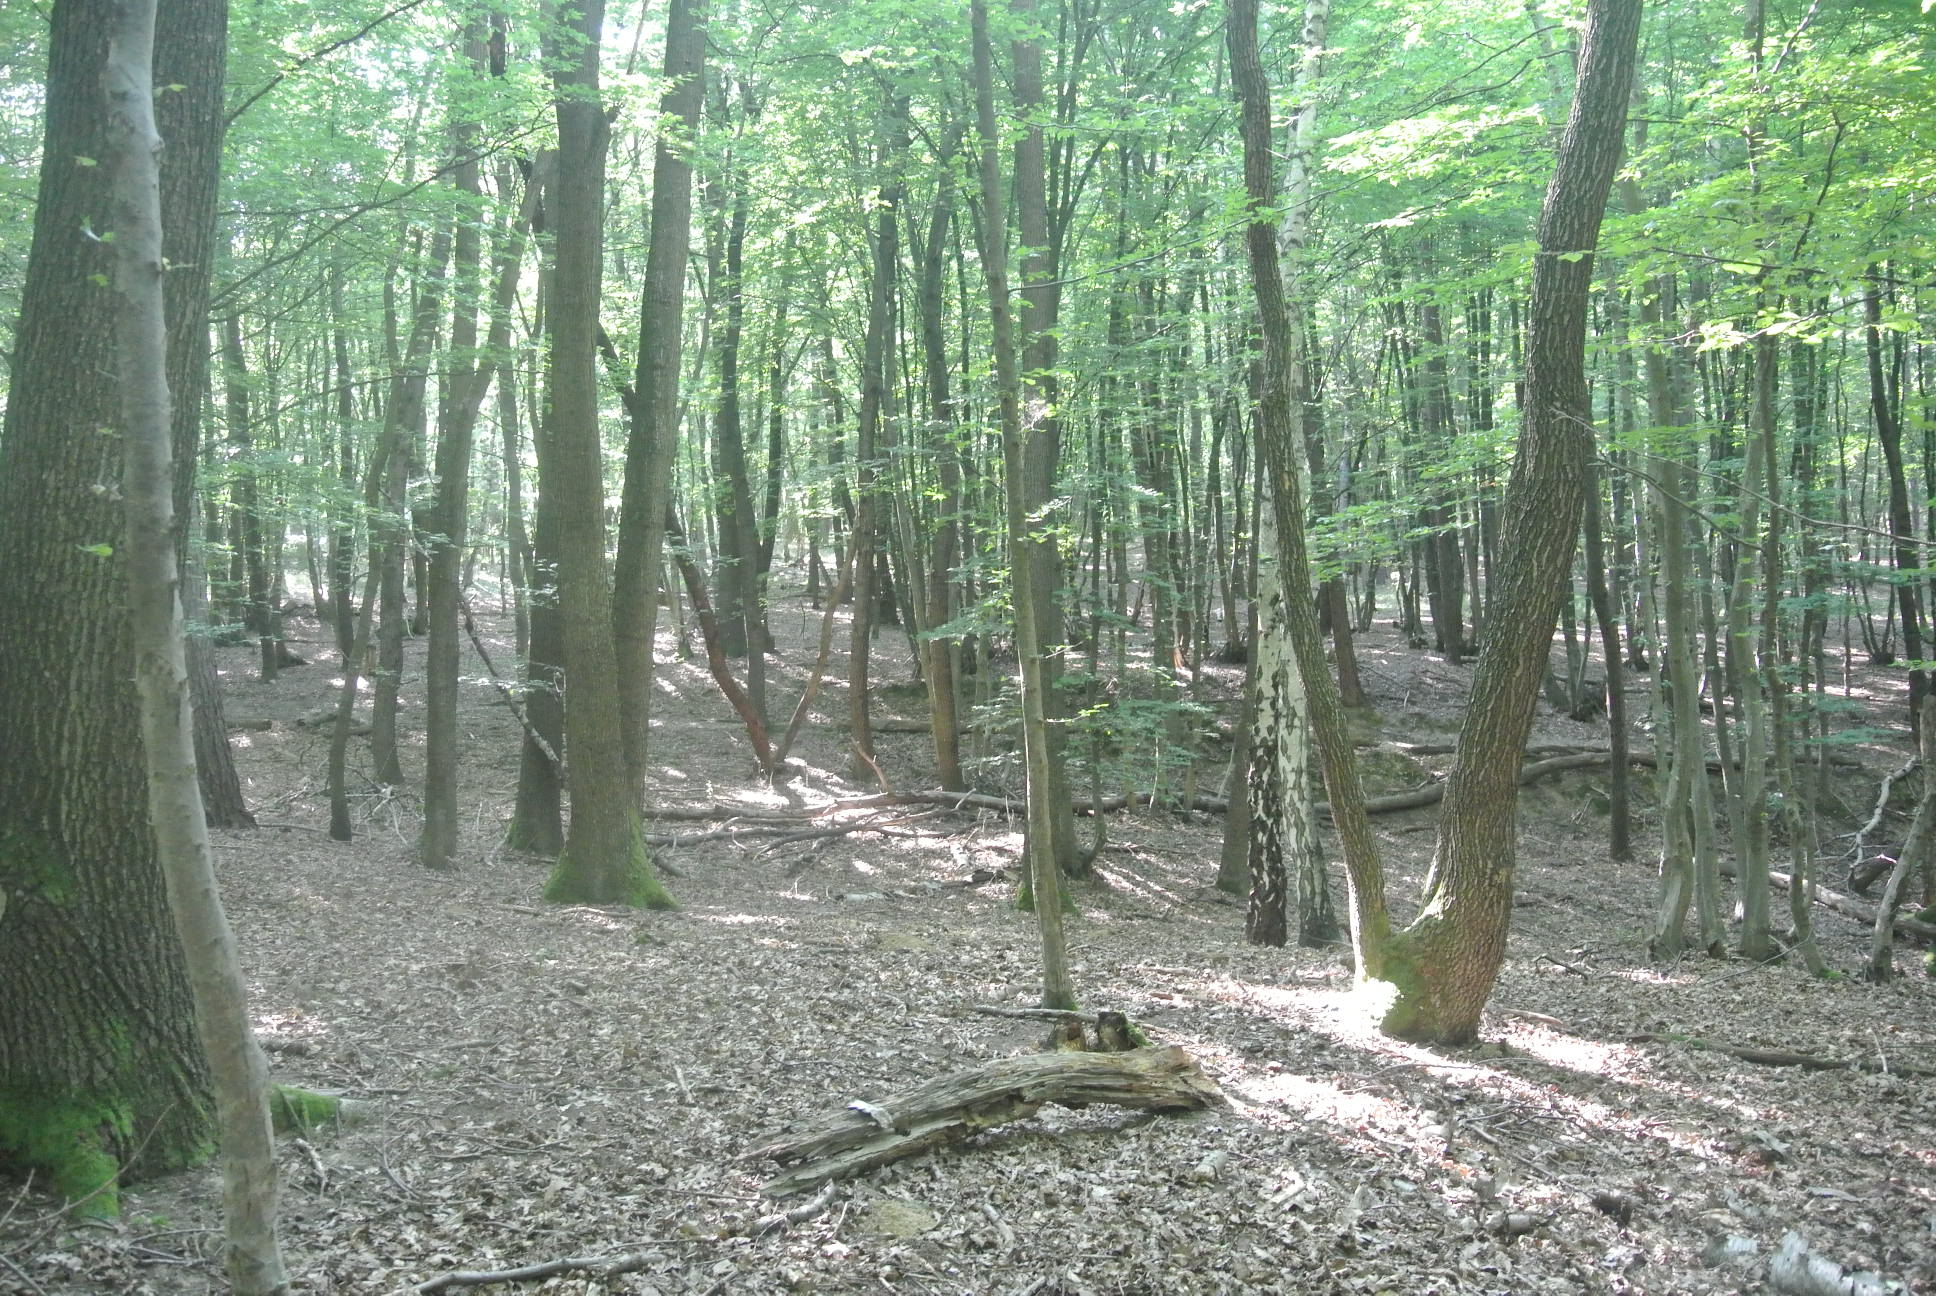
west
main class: Woodland
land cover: Broadleaved woodland
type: beech forest
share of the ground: > 75 %
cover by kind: broadleaved forest trees 100 %
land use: Forestry
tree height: > 5 m
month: July
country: AT
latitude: 47.4156
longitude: 16.5380
